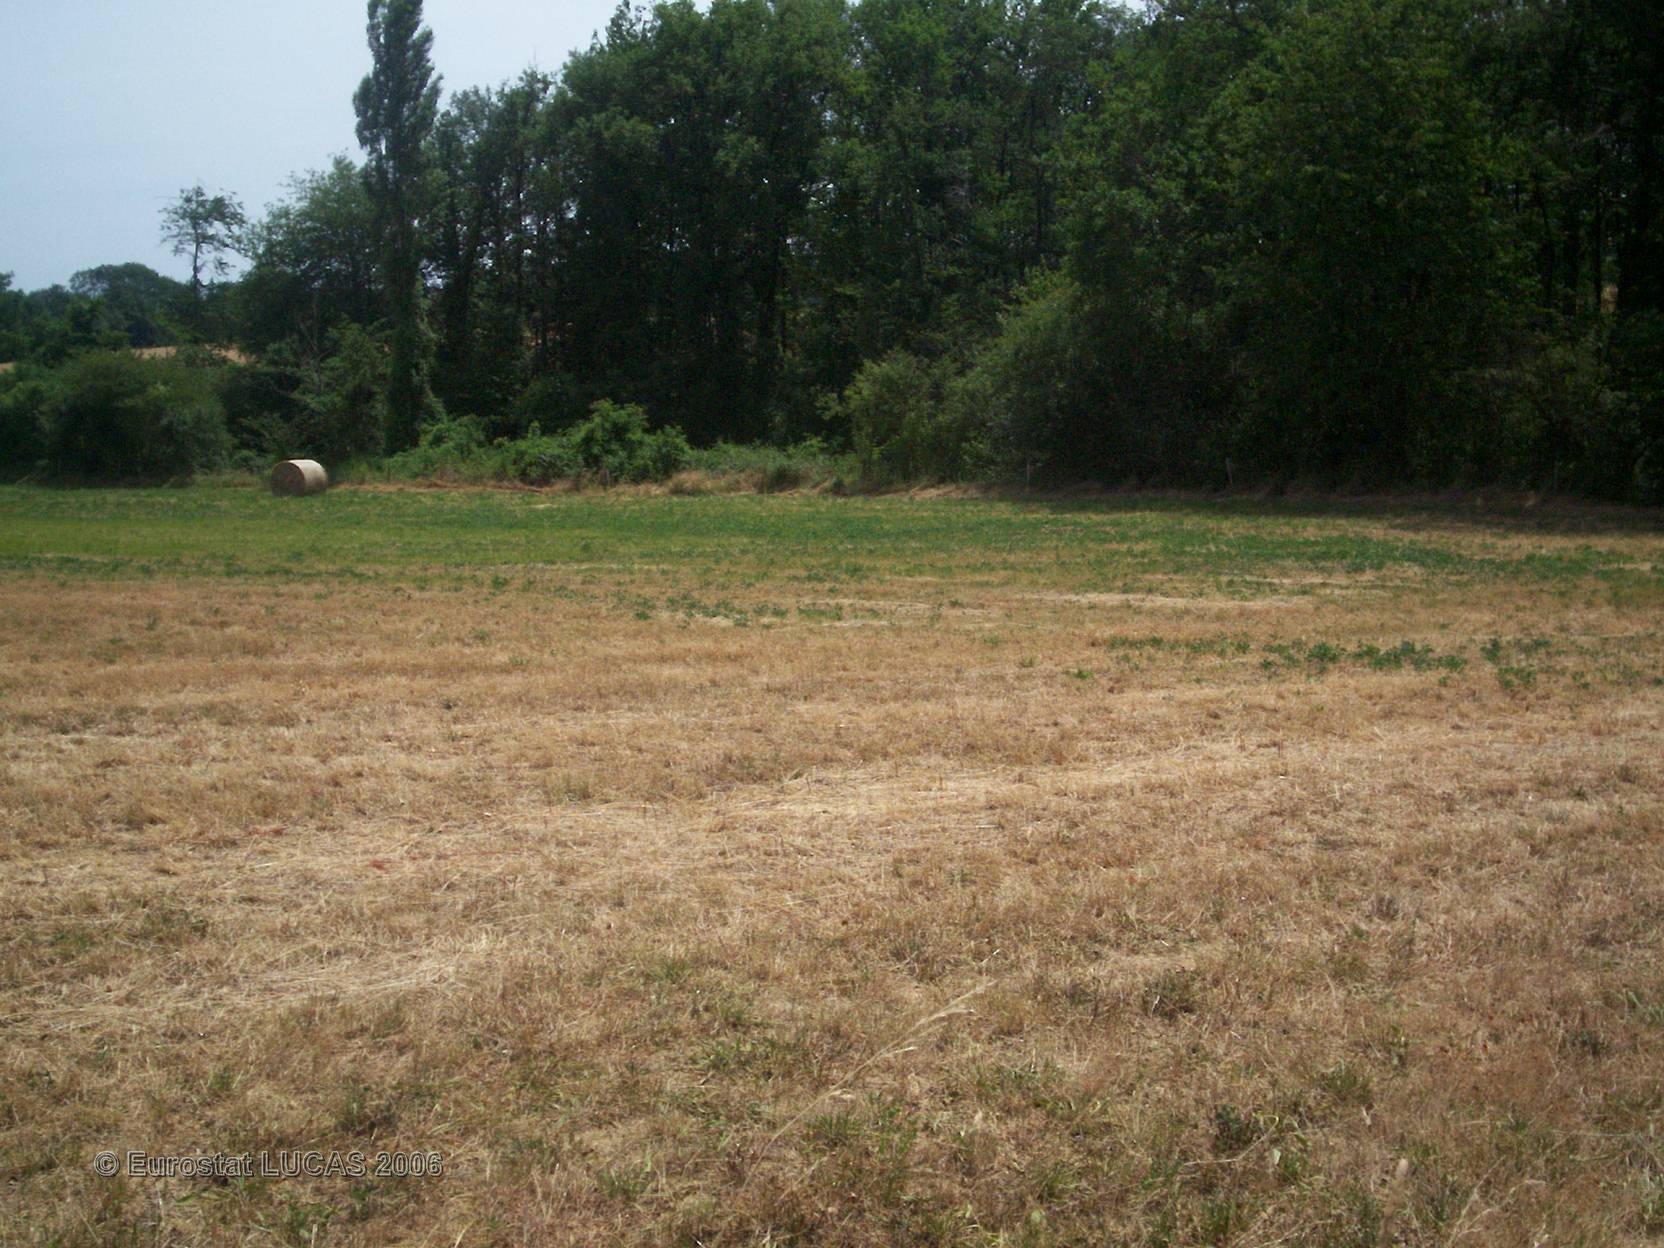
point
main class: Grassland
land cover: Grassland without tree/shrub cover
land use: Agriculture (excluding fallow land and kitchen gardens)
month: June
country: FR
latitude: 43.2144
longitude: 1.2023
